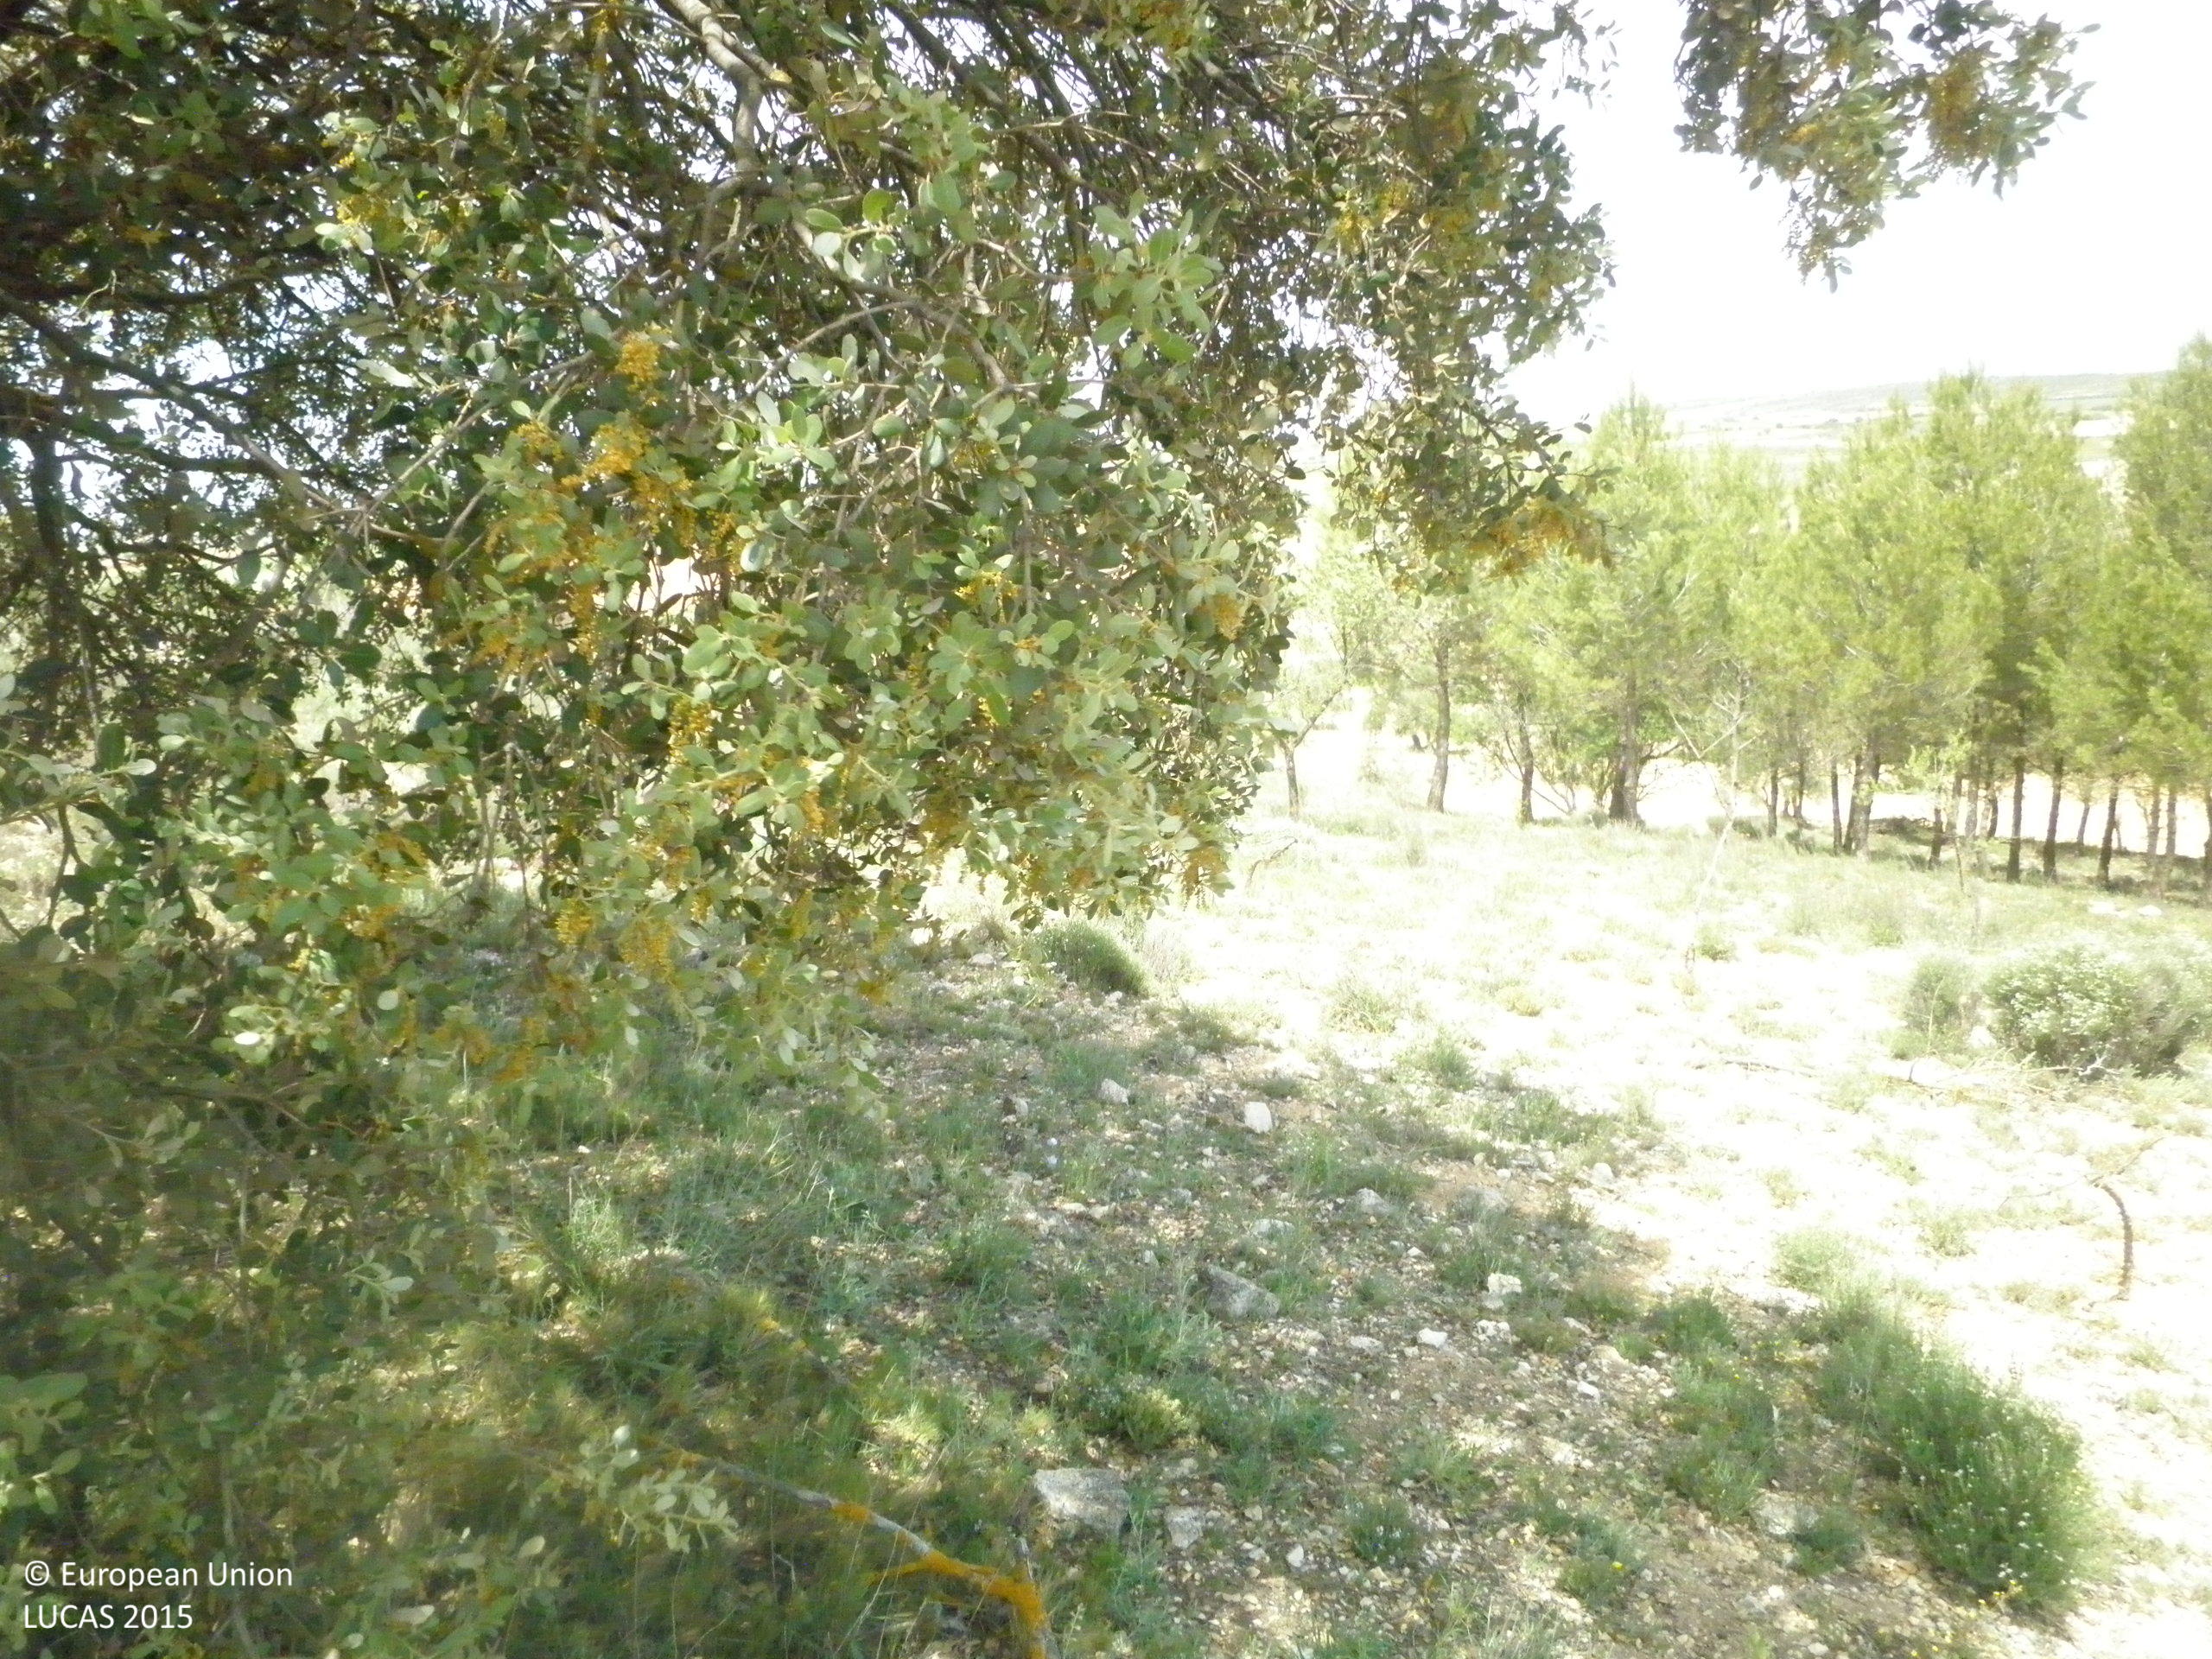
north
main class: Shrubland
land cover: Shrubland with sparse tree cover
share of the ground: 50 - 75 %
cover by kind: unconsolidated bare surface 45 %, shrubs 30 %, herbaceous plants 20 %, broadleaved forest trees 5 %
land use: Semi-natural and natural areas not in use
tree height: < 5 m
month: May
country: ES
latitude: 39.5824
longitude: -2.7174
